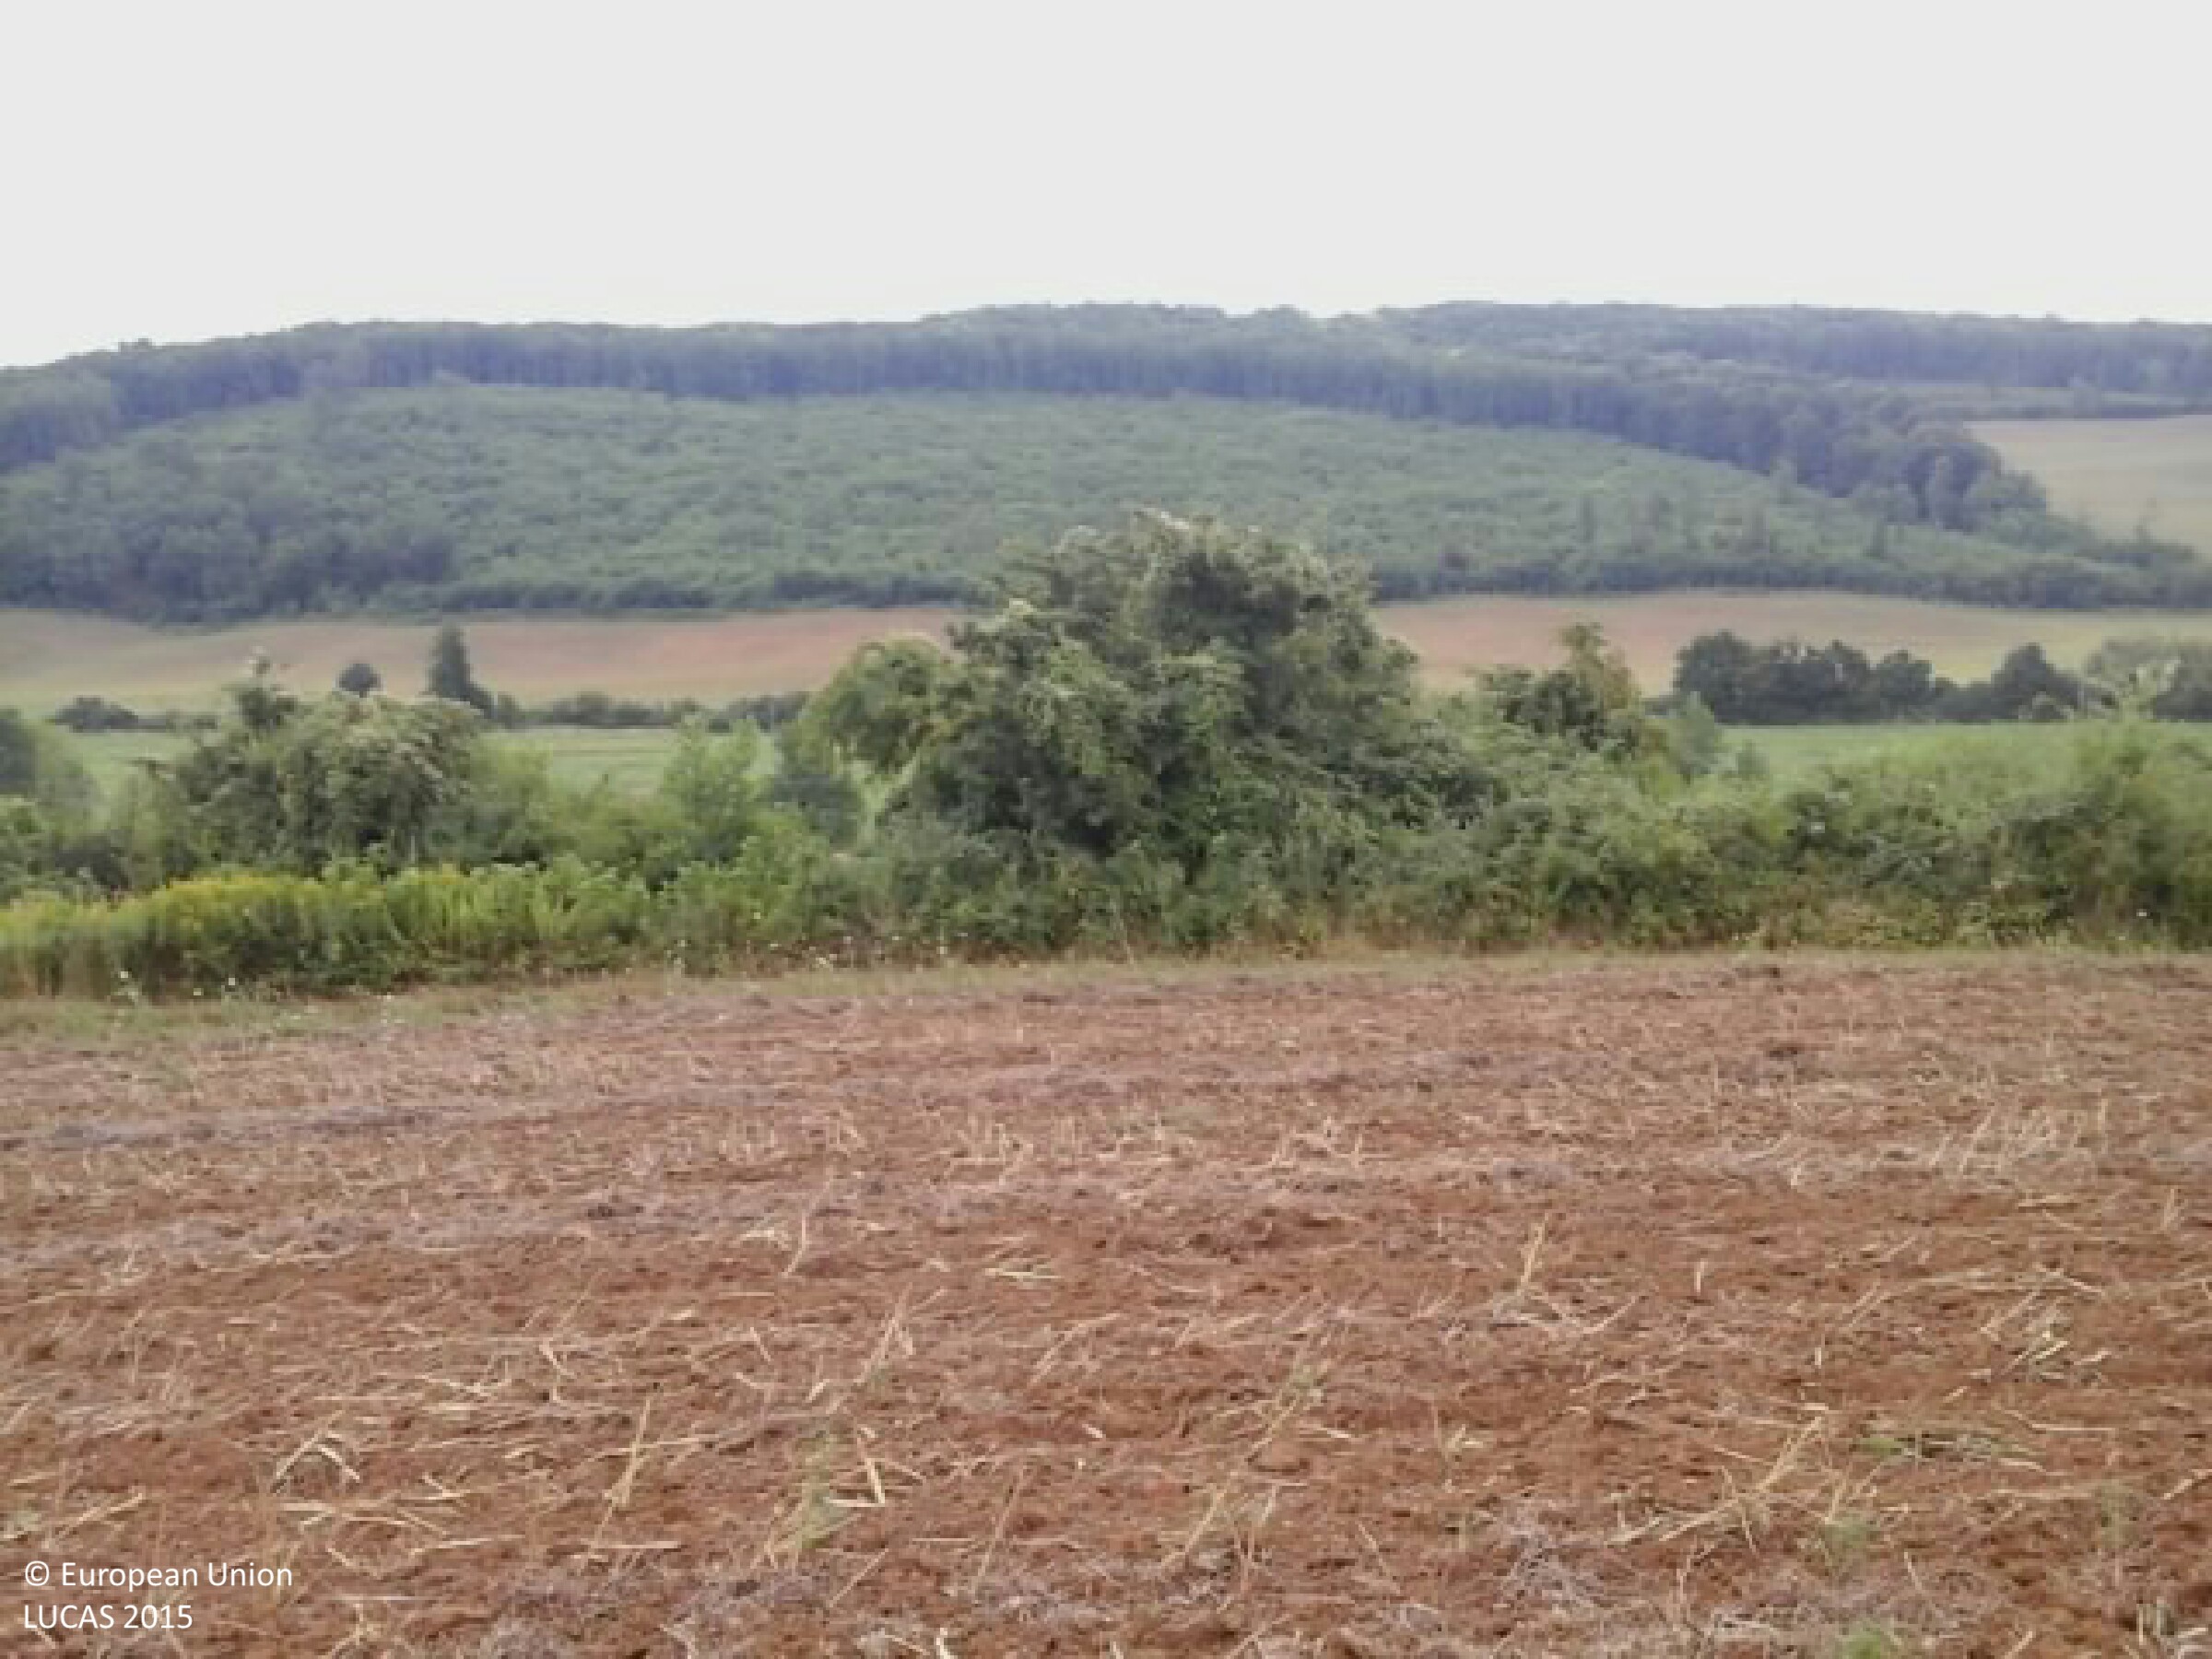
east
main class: Cropland
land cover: Rape and turnip rape
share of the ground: > 75 %
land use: Agriculture (excluding fallow land and kitchen gardens)
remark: Harvested field
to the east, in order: Rape and turnip rape; Abandoned hedges; Rape and turnip rape; Grass margins; Electric lines; Grass margins; Paved roads, cycling and walking lanes; Electric lines; Lines of trees; Grassland without tree/shrub cover; Soya; Electric lines; Soya
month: July
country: HU
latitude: 46.2534
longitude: 17.9580
